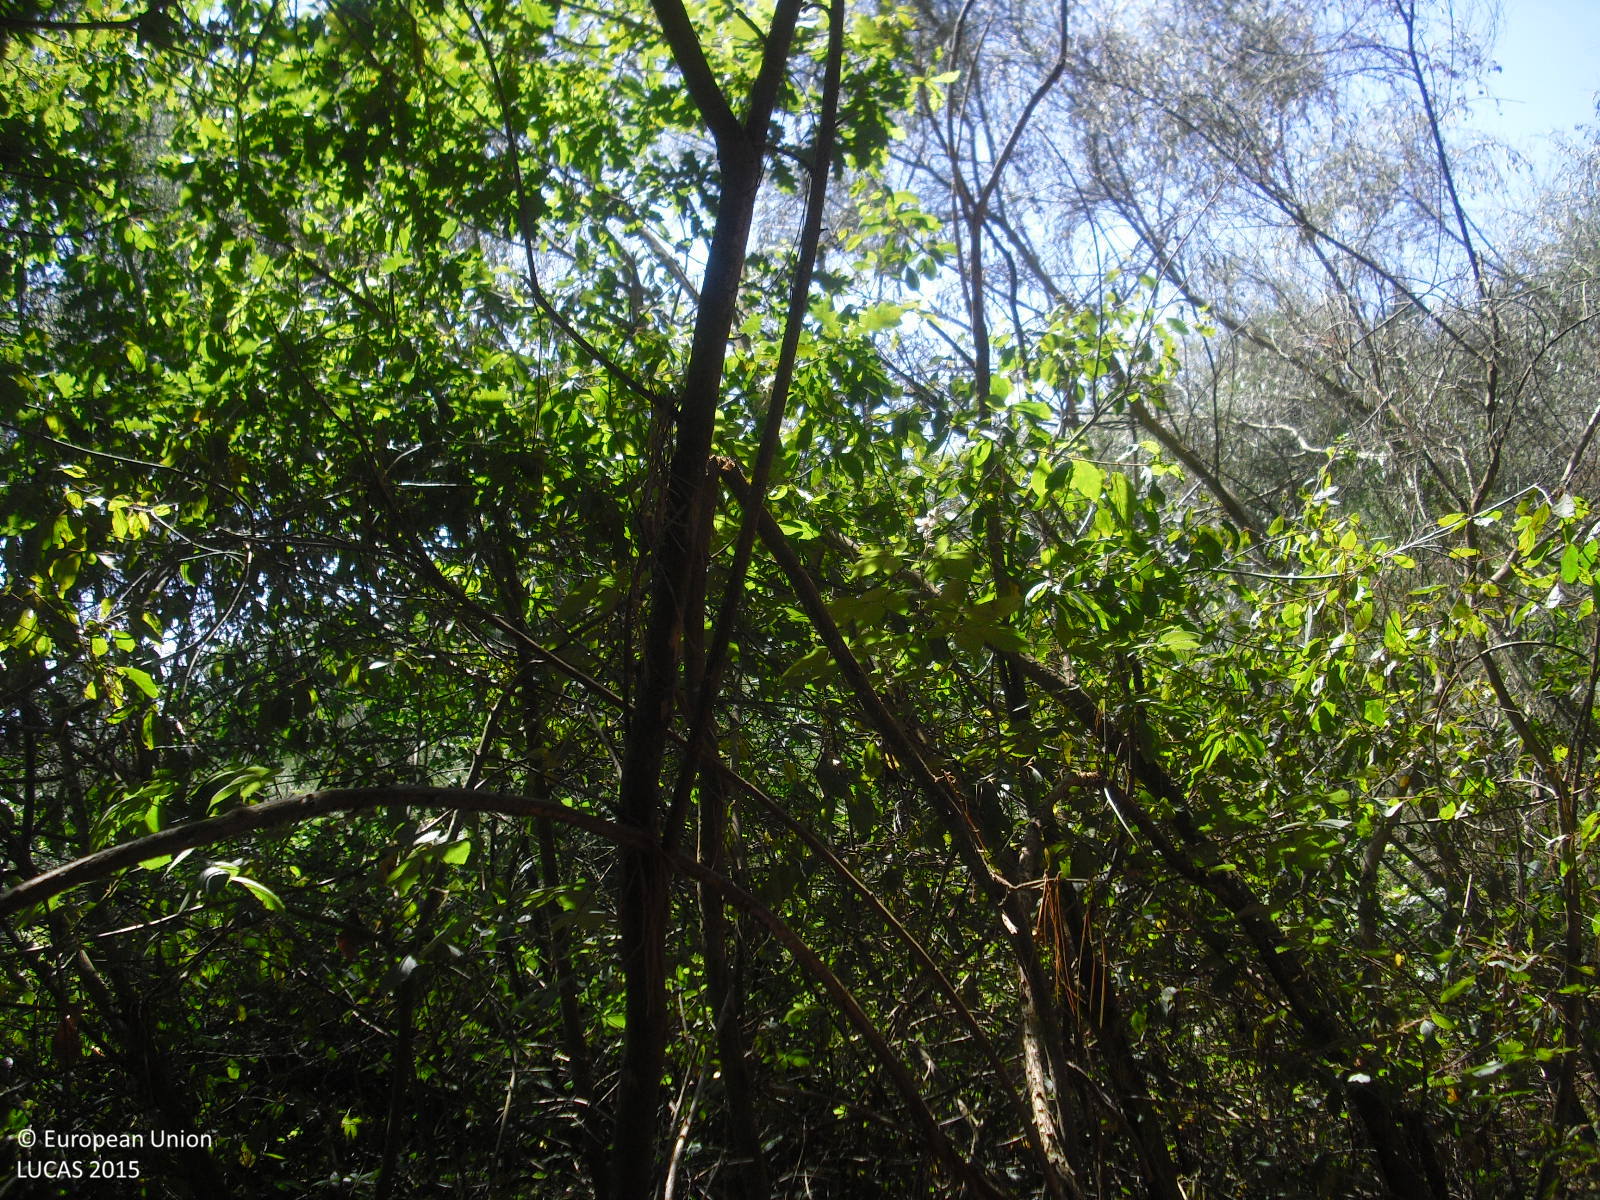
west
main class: Shrubland
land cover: Shrubland with sparse tree cover
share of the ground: > 75 %
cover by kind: shrubs 95 %, broadleaved forest trees 5 %
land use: Abandoned areas
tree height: < 5 m
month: July
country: ES
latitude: 42.6555
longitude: -7.5535
